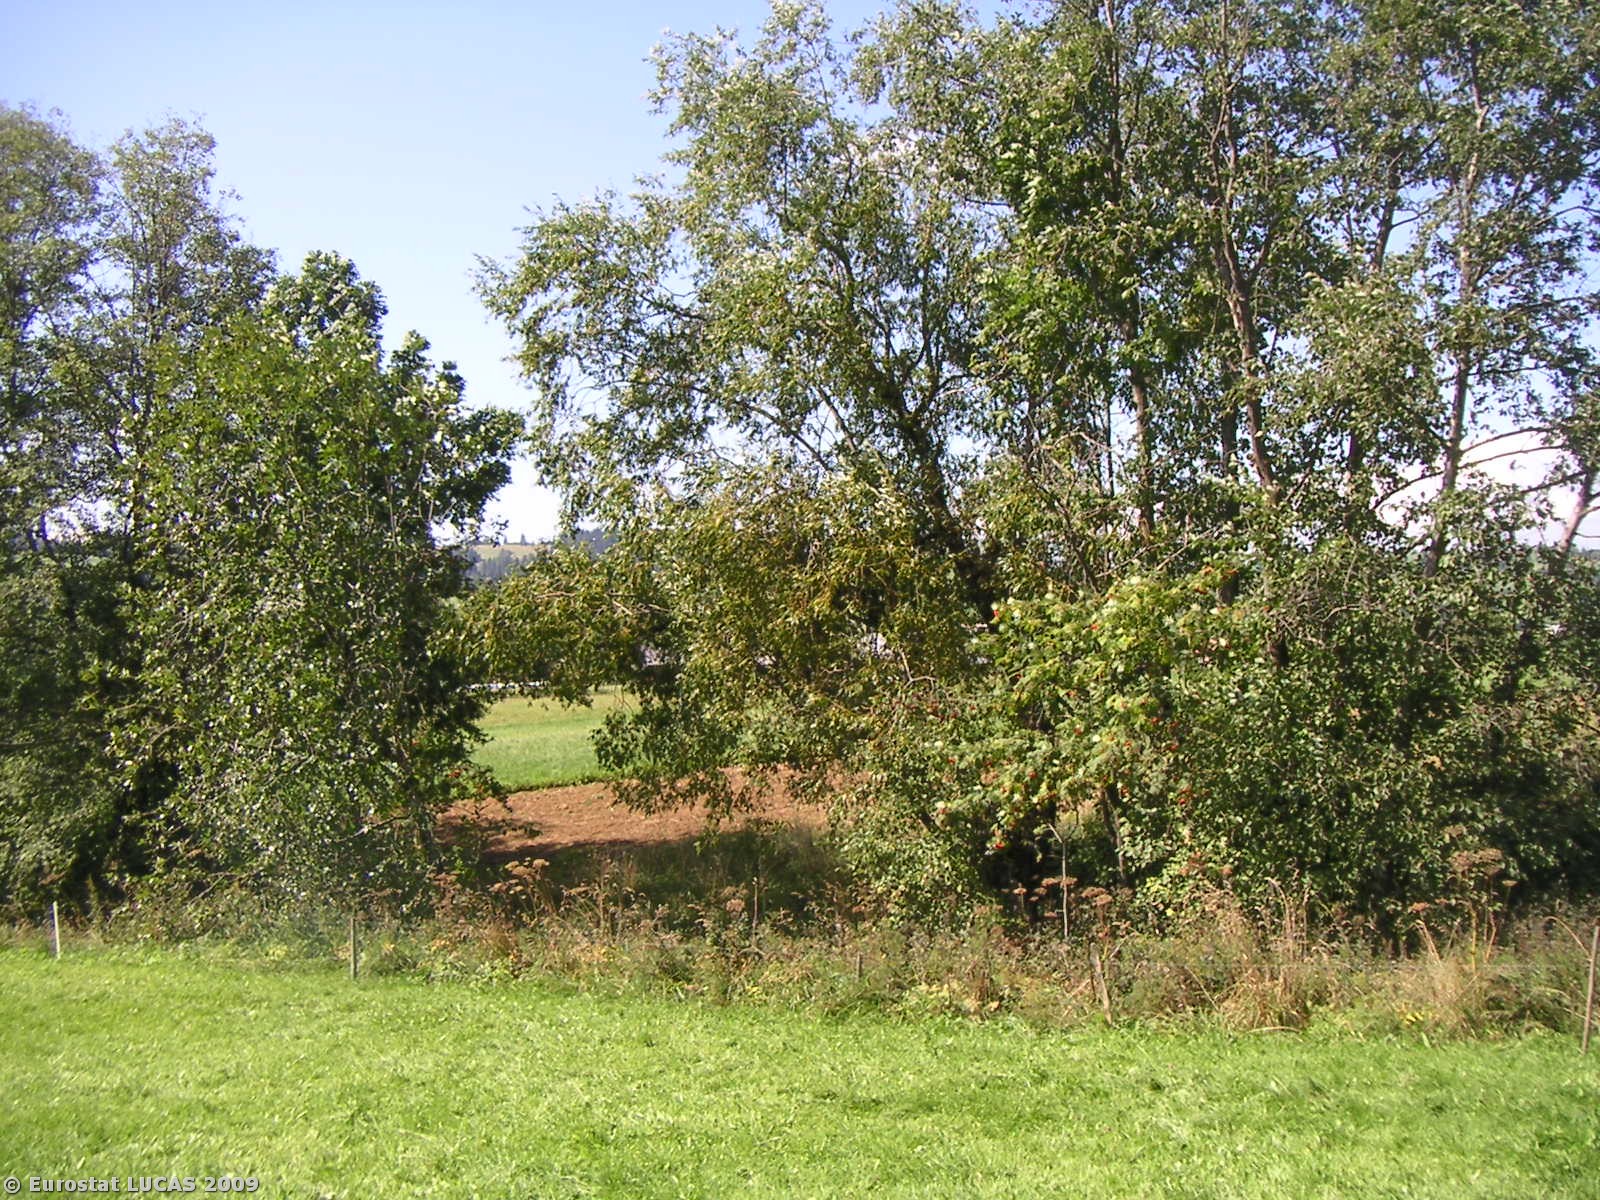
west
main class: Grassland
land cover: Grassland without tree/shrub cover
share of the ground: > 75 %
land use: Agriculture (excluding fallow land and kitchen gardens)
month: September
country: PL
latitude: 49.3406
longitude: 19.8429
